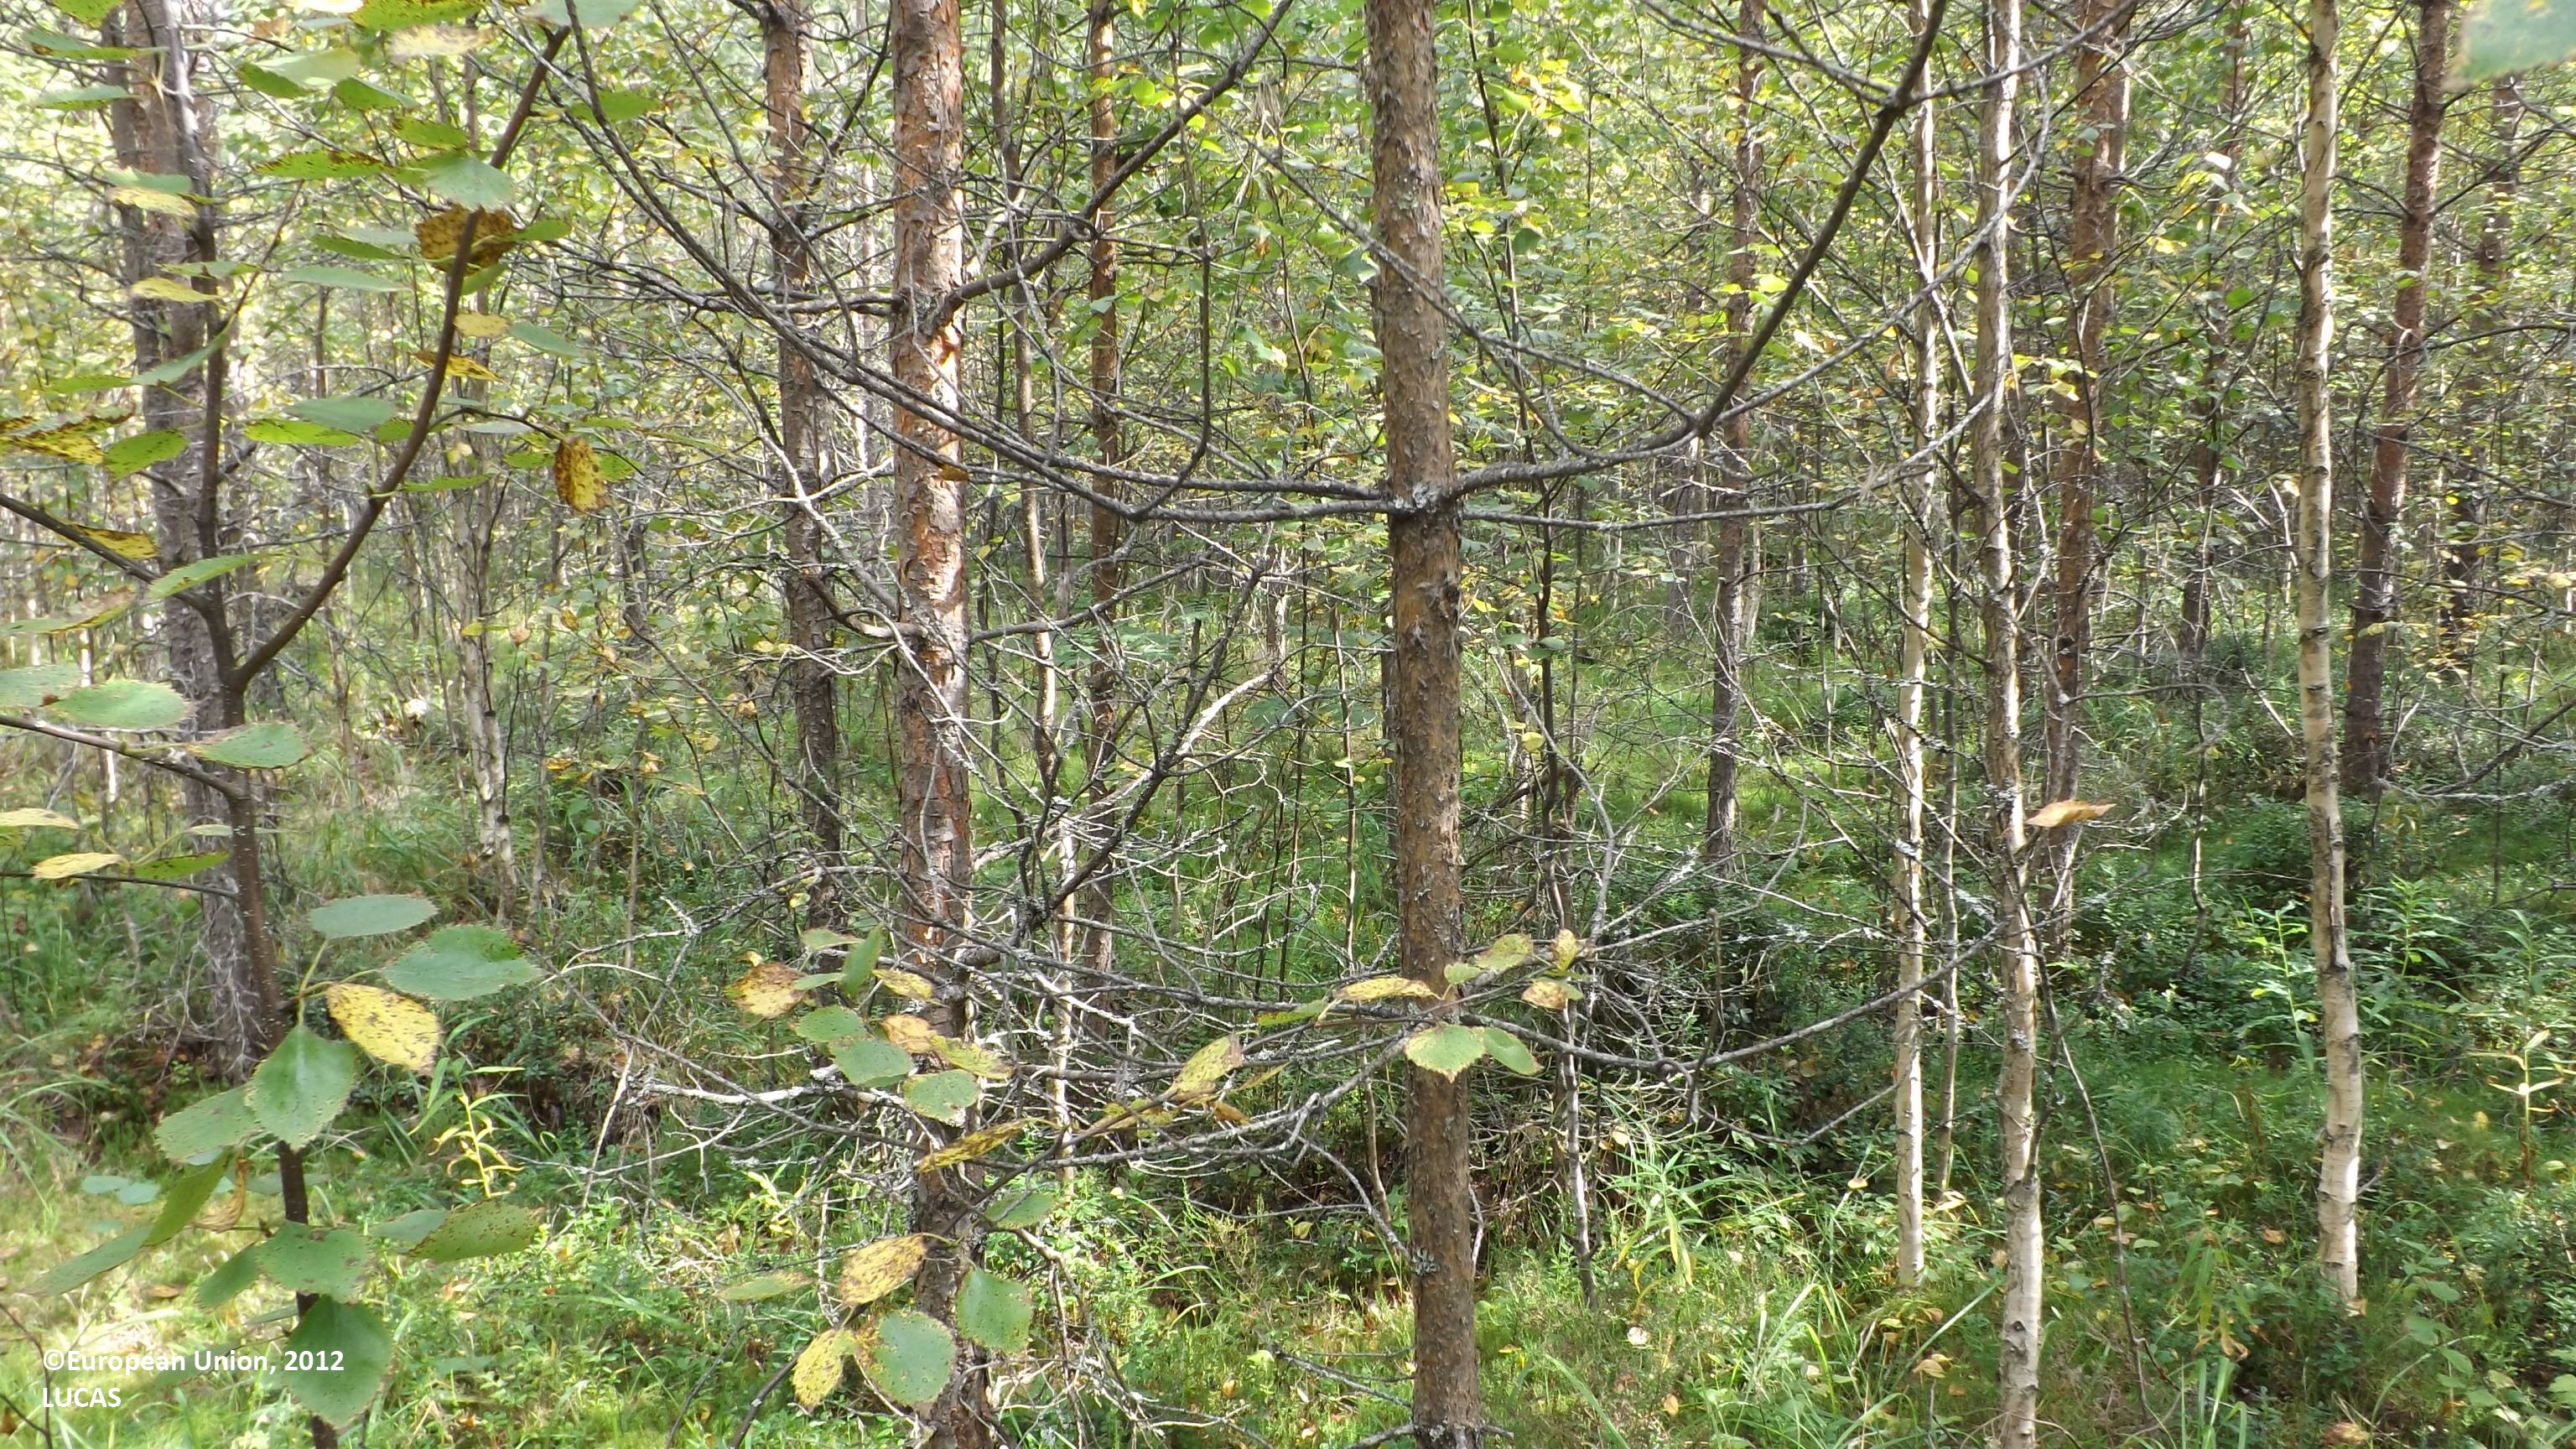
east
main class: Woodland
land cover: Pine dominated mixed woodland
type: boreal forest
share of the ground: > 75 %
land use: Forestry
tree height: > 5 m
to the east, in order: Pine dominated mixed woodland; Other mixed woodland; Ditches and canals; Broadleaved woodland; Pine dominated mixed woodland; Other mixed woodland; Spontaneously vegetated surfaces; Pine dominated mixed woodland; Ditches and canals; Other mixed woodland
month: August
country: FI
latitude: 63.0995
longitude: 24.3247
